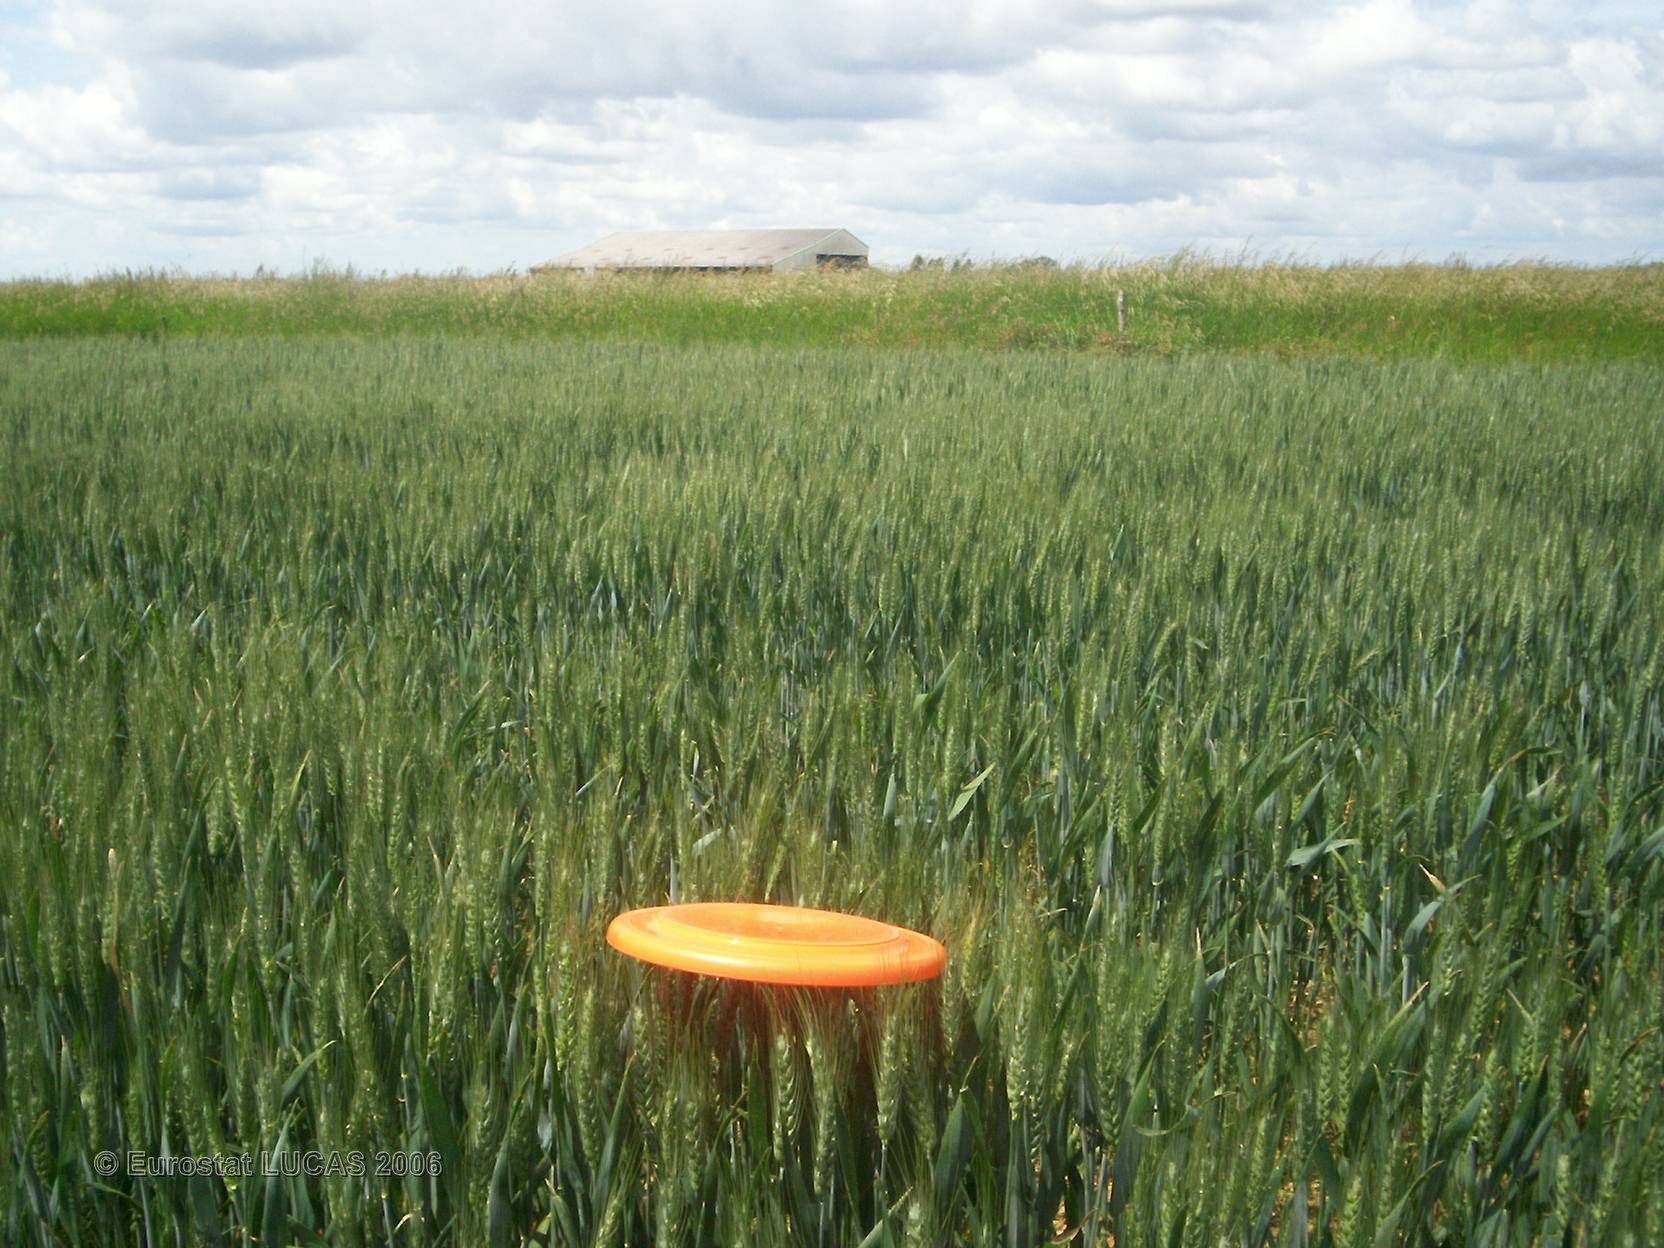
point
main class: Cropland
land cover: Common wheat
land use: Agriculture (excluding fallow land and kitchen gardens)
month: May
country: FR
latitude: 46.3884
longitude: -0.7567
